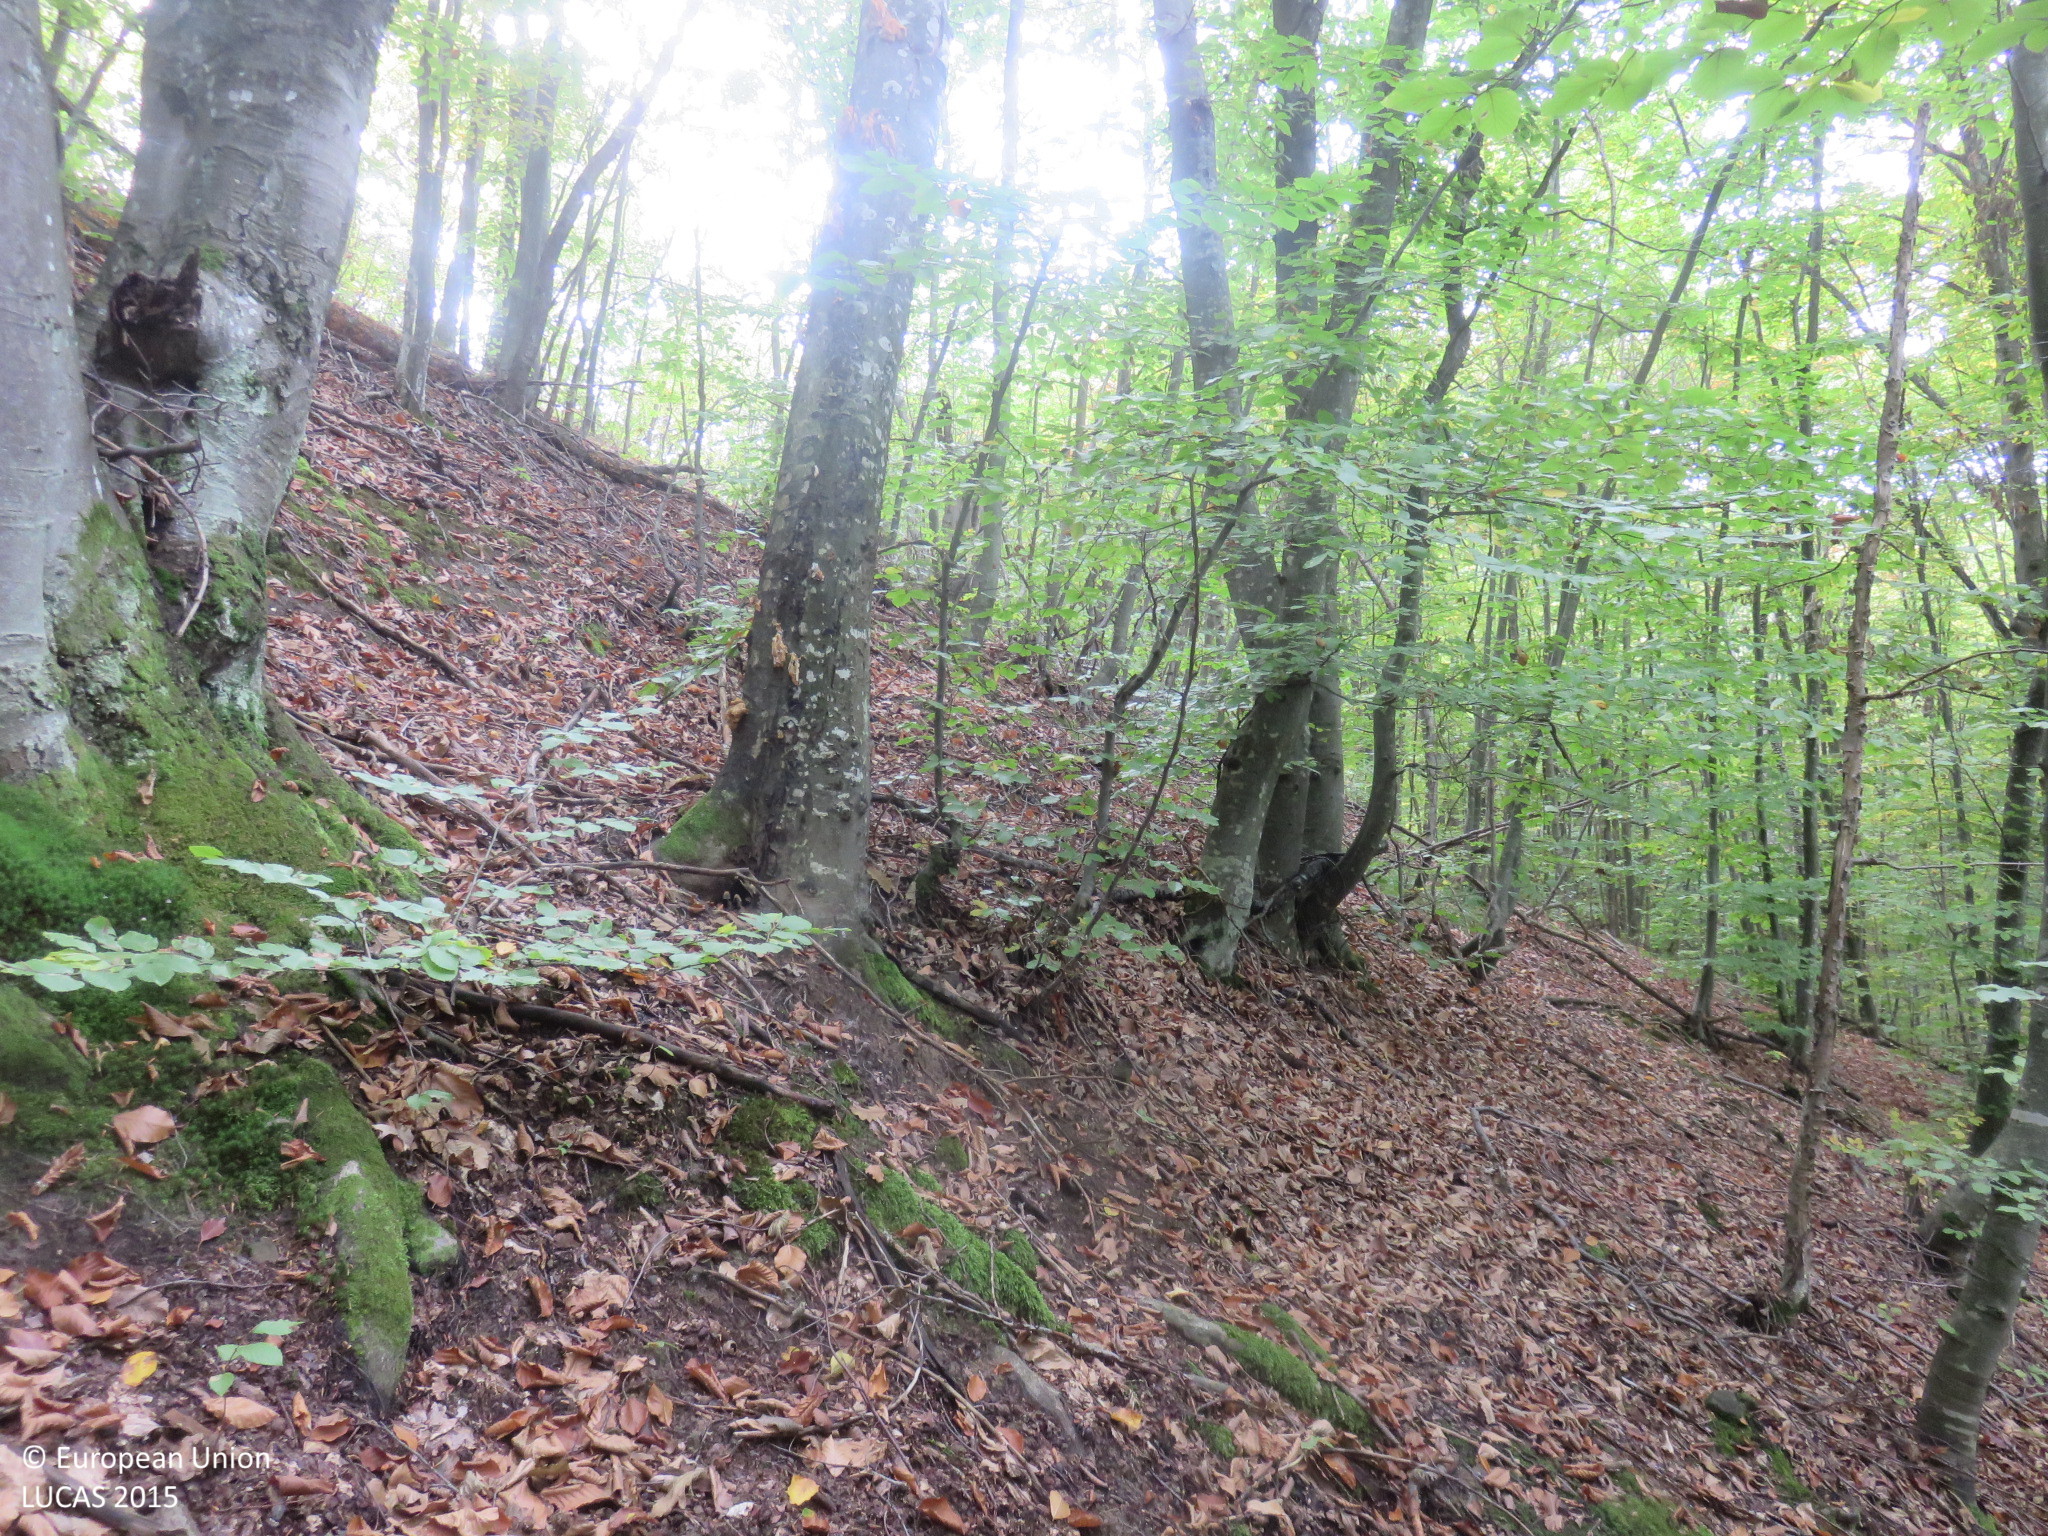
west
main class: Woodland
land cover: Broadleaved woodland
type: beech forest
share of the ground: > 75 %
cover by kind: broadleaved forest trees 85 %, unconsolidated bare surface 10 %, shrubs 5 %
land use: Forestry
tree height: > 5 m
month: October
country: BG
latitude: 42.9090
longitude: 24.9709
